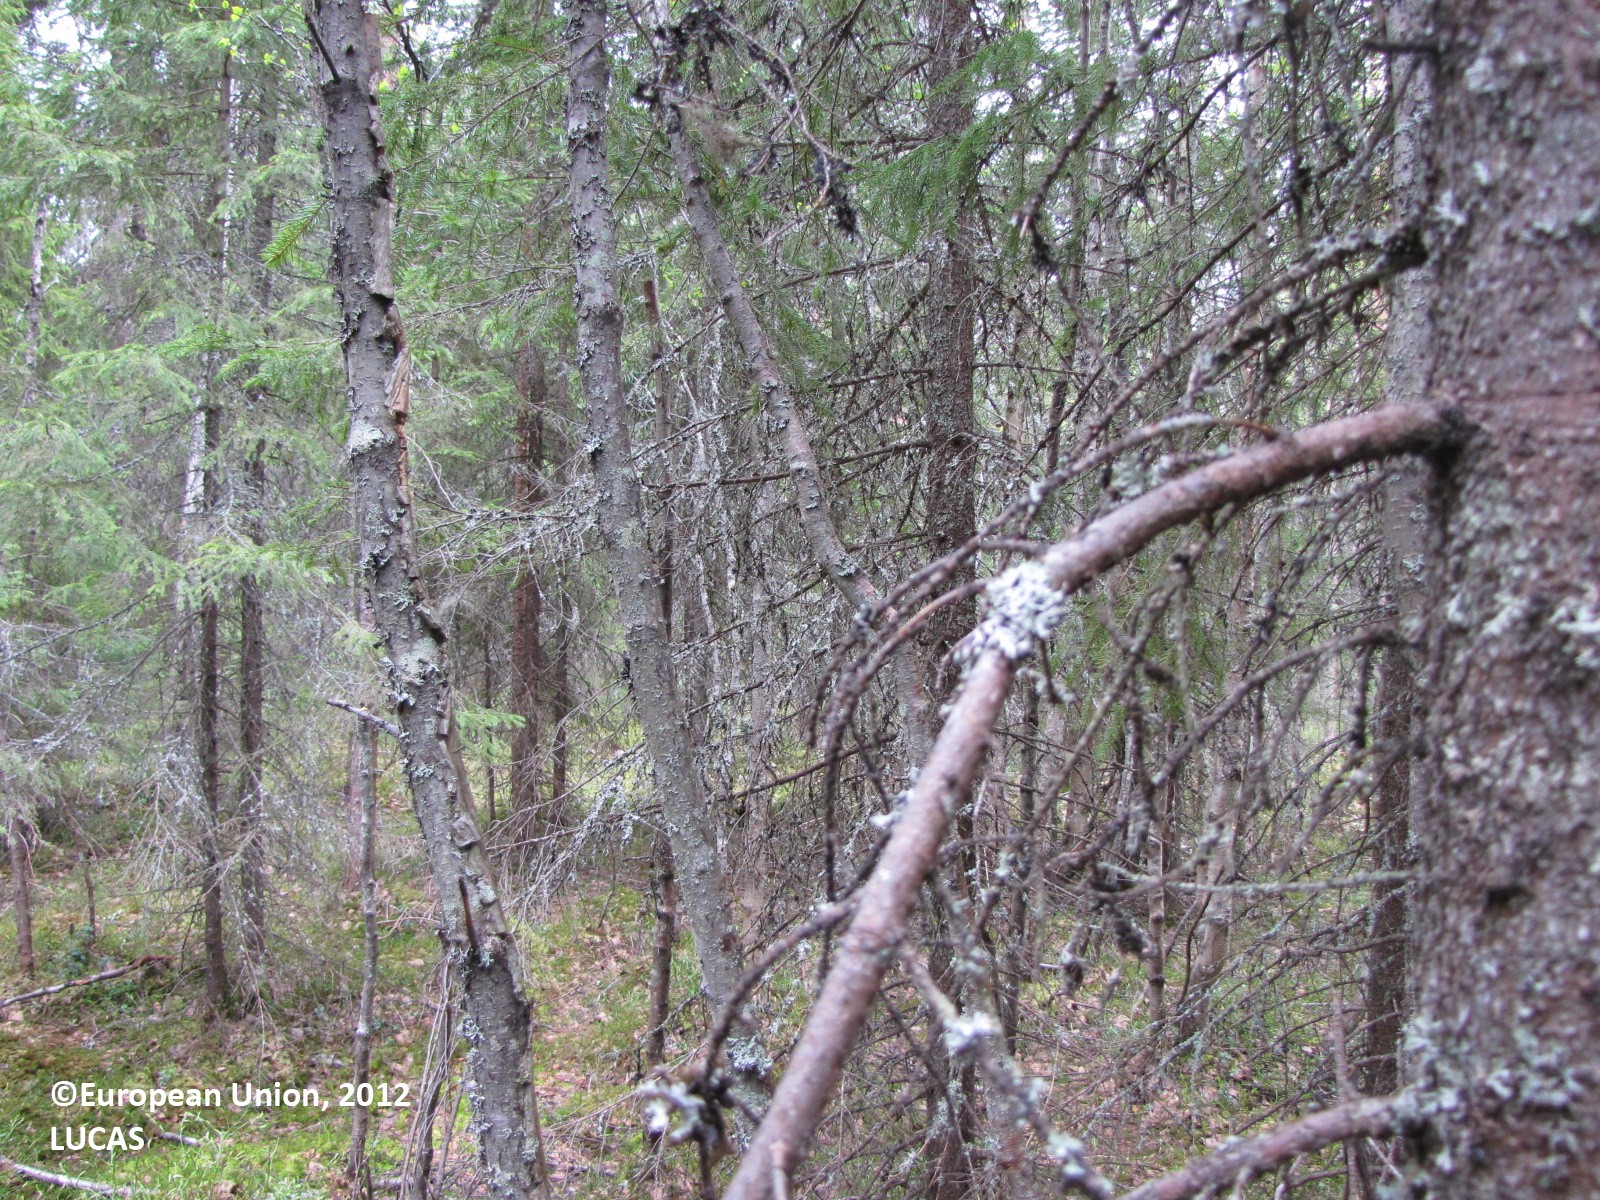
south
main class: Woodland
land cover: Spruce dominated mixed woodland
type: boreal forest
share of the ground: > 75 %
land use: Forestry
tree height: > 5 m
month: June
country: FI
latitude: 65.8110
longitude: 24.5109
